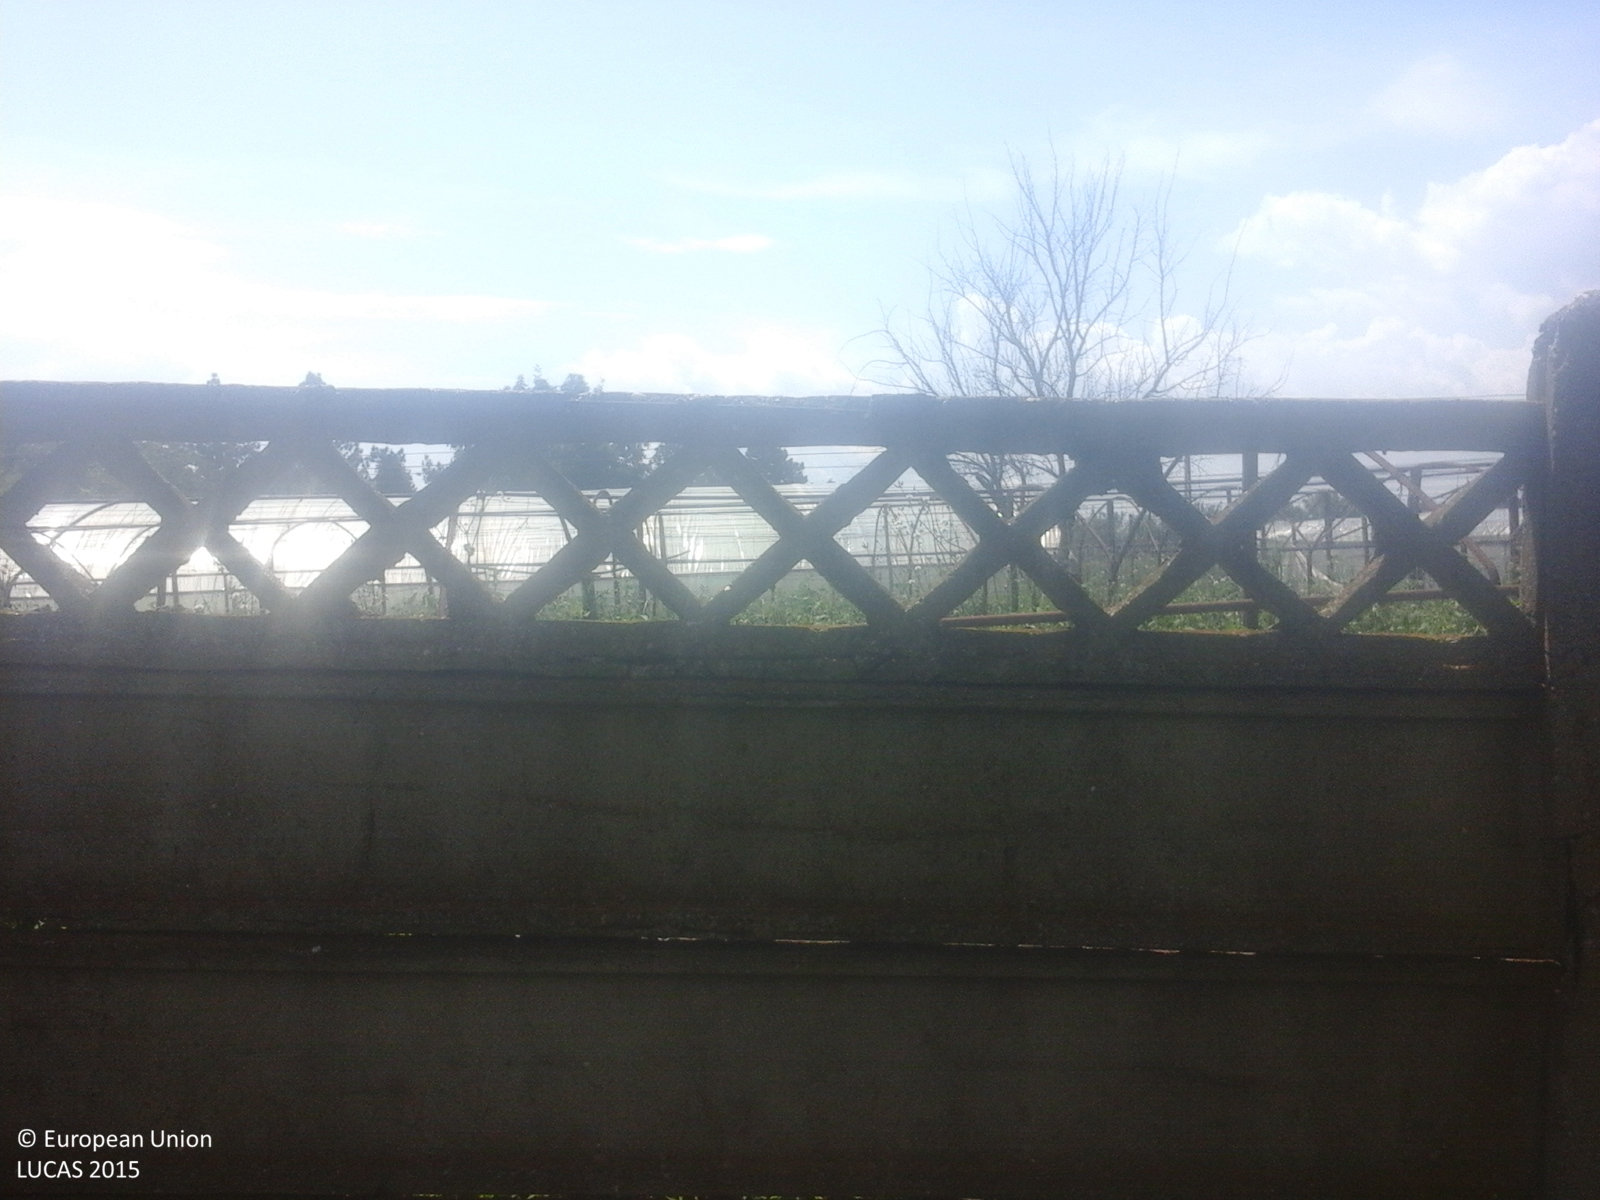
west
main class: Artificial land
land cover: Greenhouses
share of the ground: > 75 %
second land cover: Tomatoes
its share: > 75 %
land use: Agriculture (excluding fallow land and kitchen gardens)
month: July
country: RO
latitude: 43.8167
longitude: 24.6511
